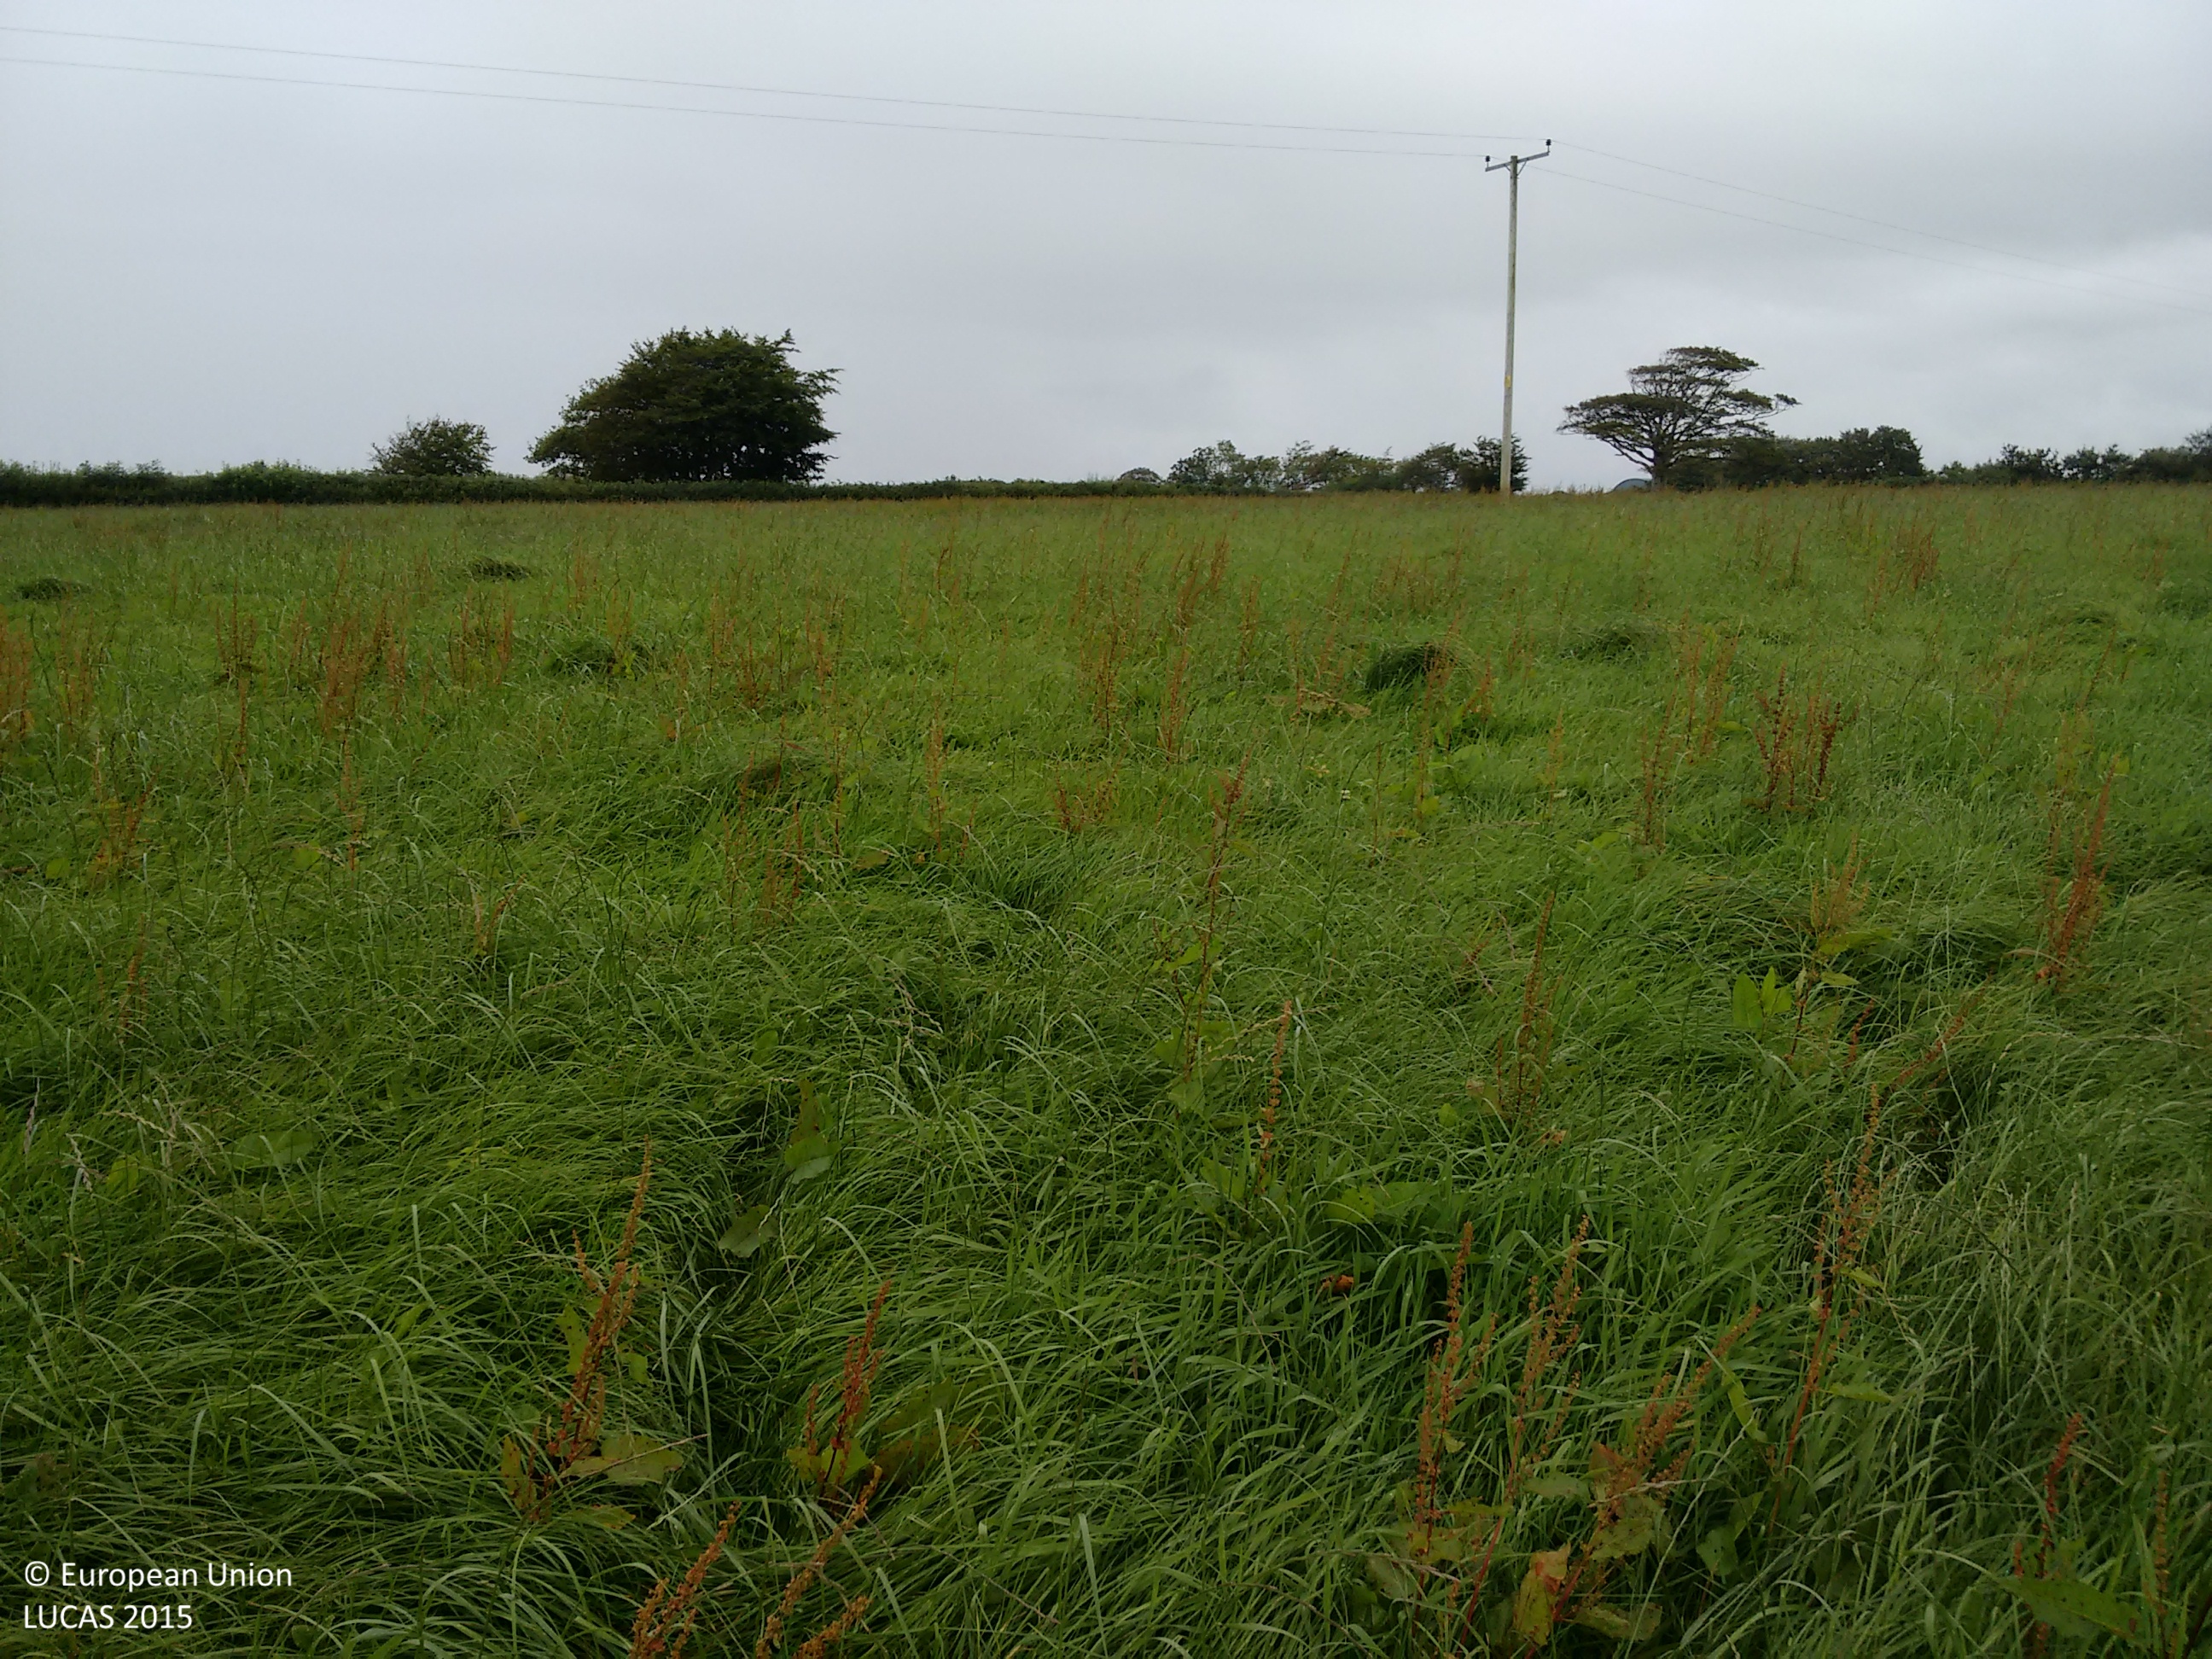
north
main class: Grassland
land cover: Grassland without tree/shrub cover
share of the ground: > 75 %
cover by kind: herbaceous plants 100 %
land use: Agriculture (excluding fallow land and kitchen gardens)
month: September
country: GB
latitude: 50.9286
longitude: -3.7913
